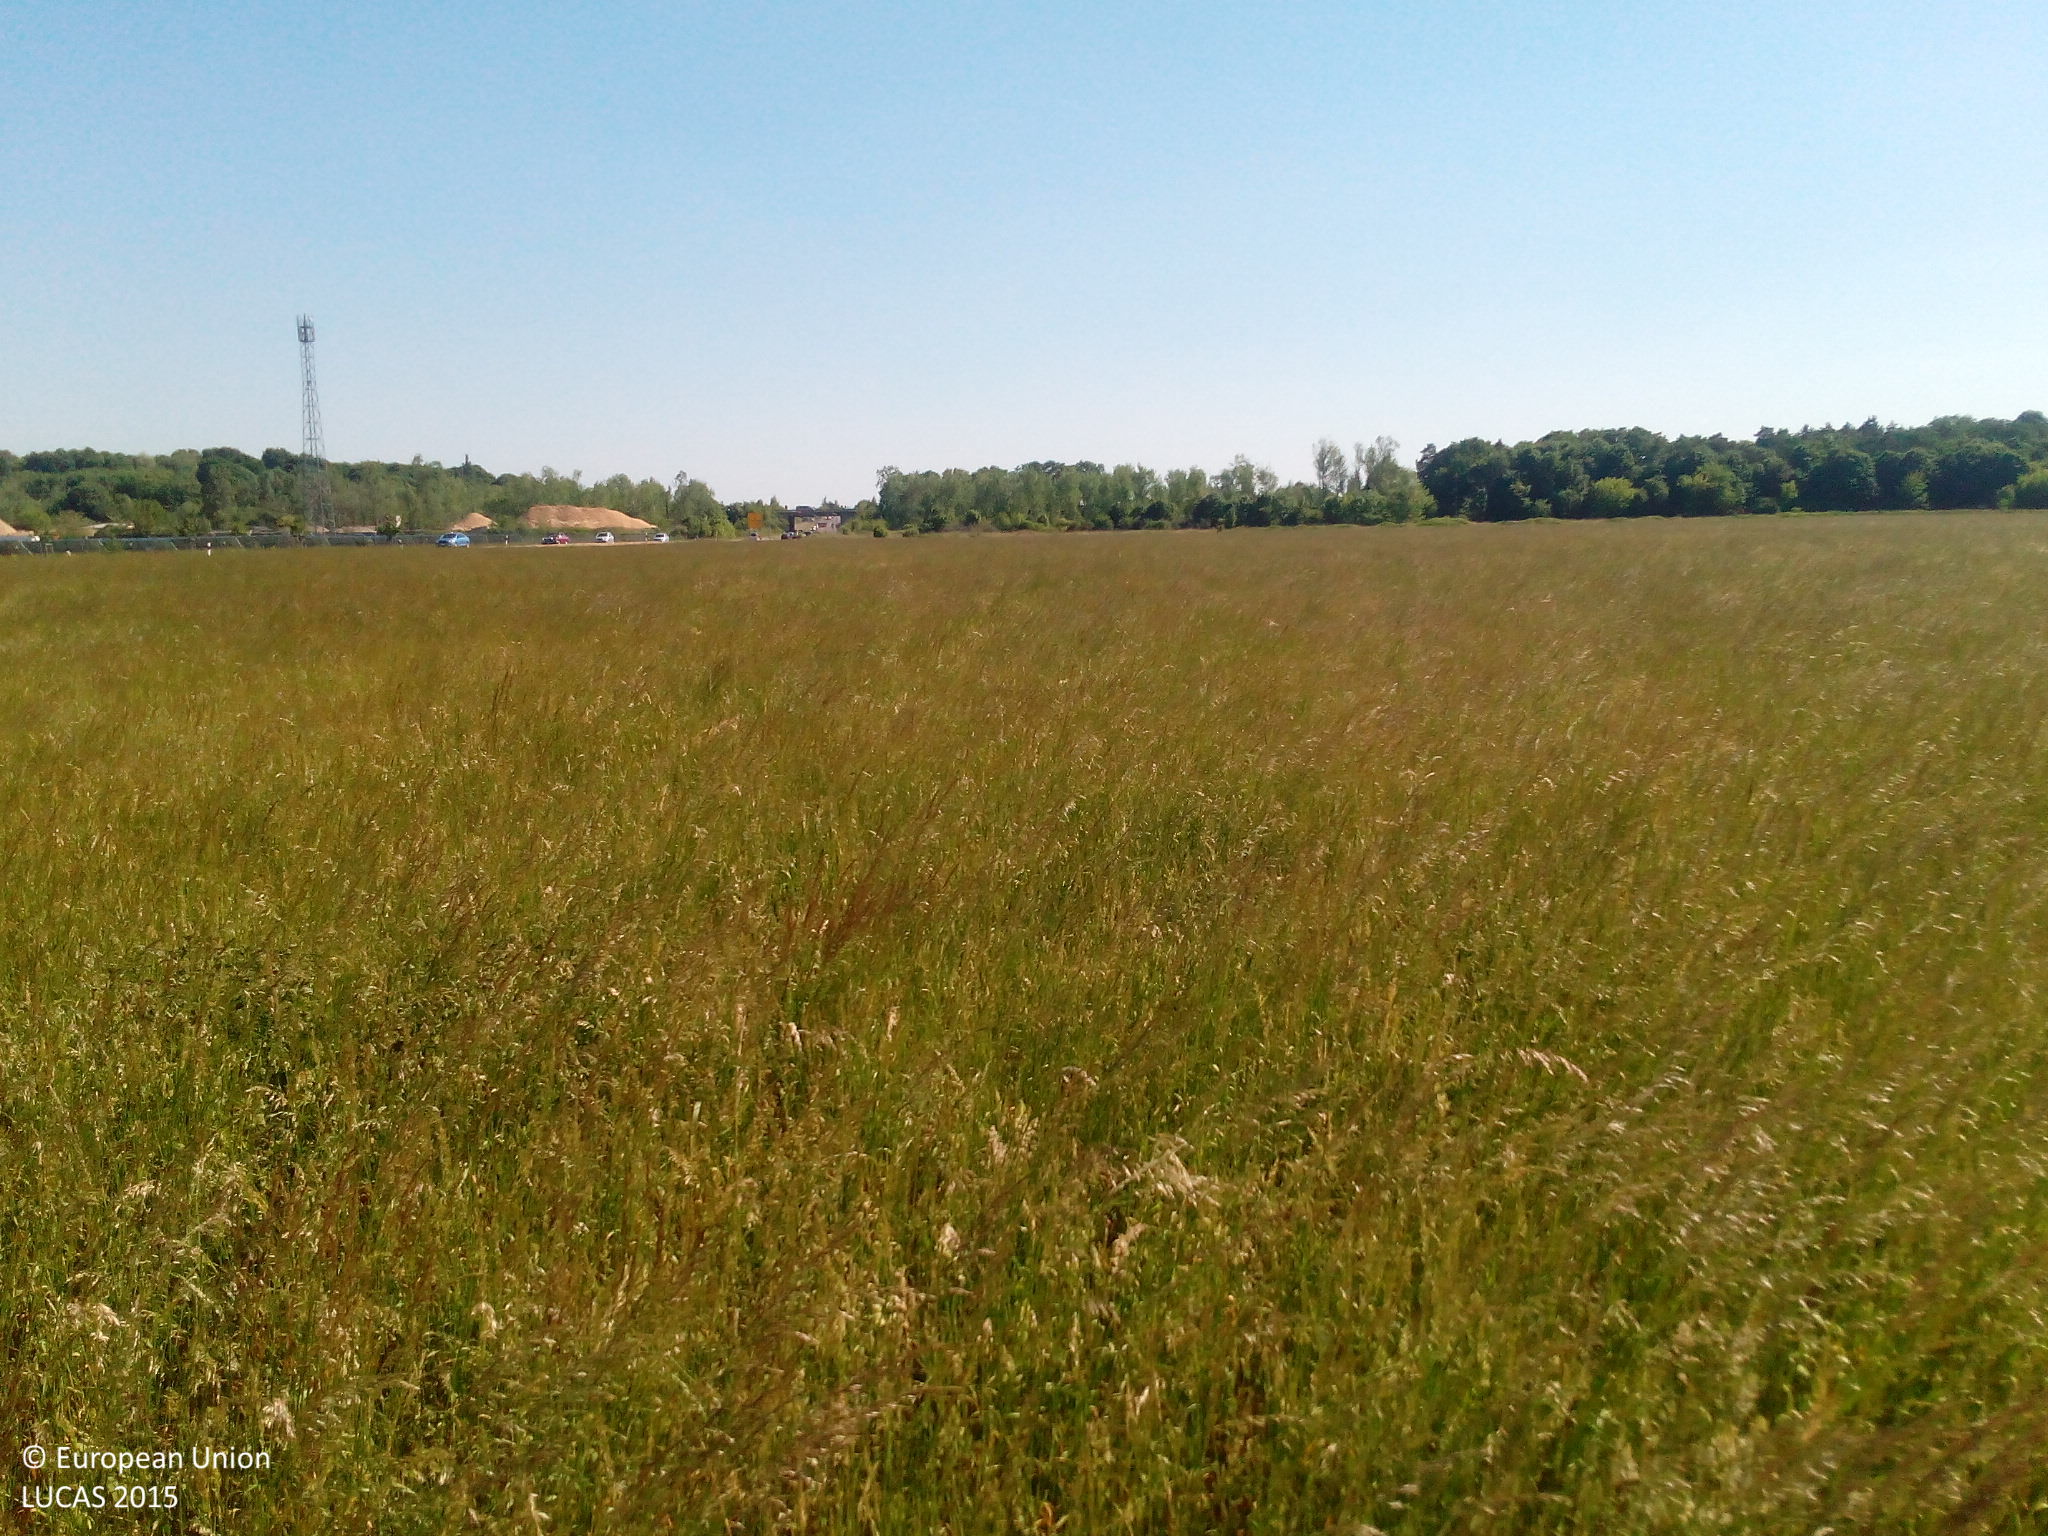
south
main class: Grassland
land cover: Grassland without tree/shrub cover
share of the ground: > 75 %
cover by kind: herbaceous plants 100 %
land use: Agriculture (excluding fallow land and kitchen gardens)
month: June
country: DE
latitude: 52.5346
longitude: 13.1105
